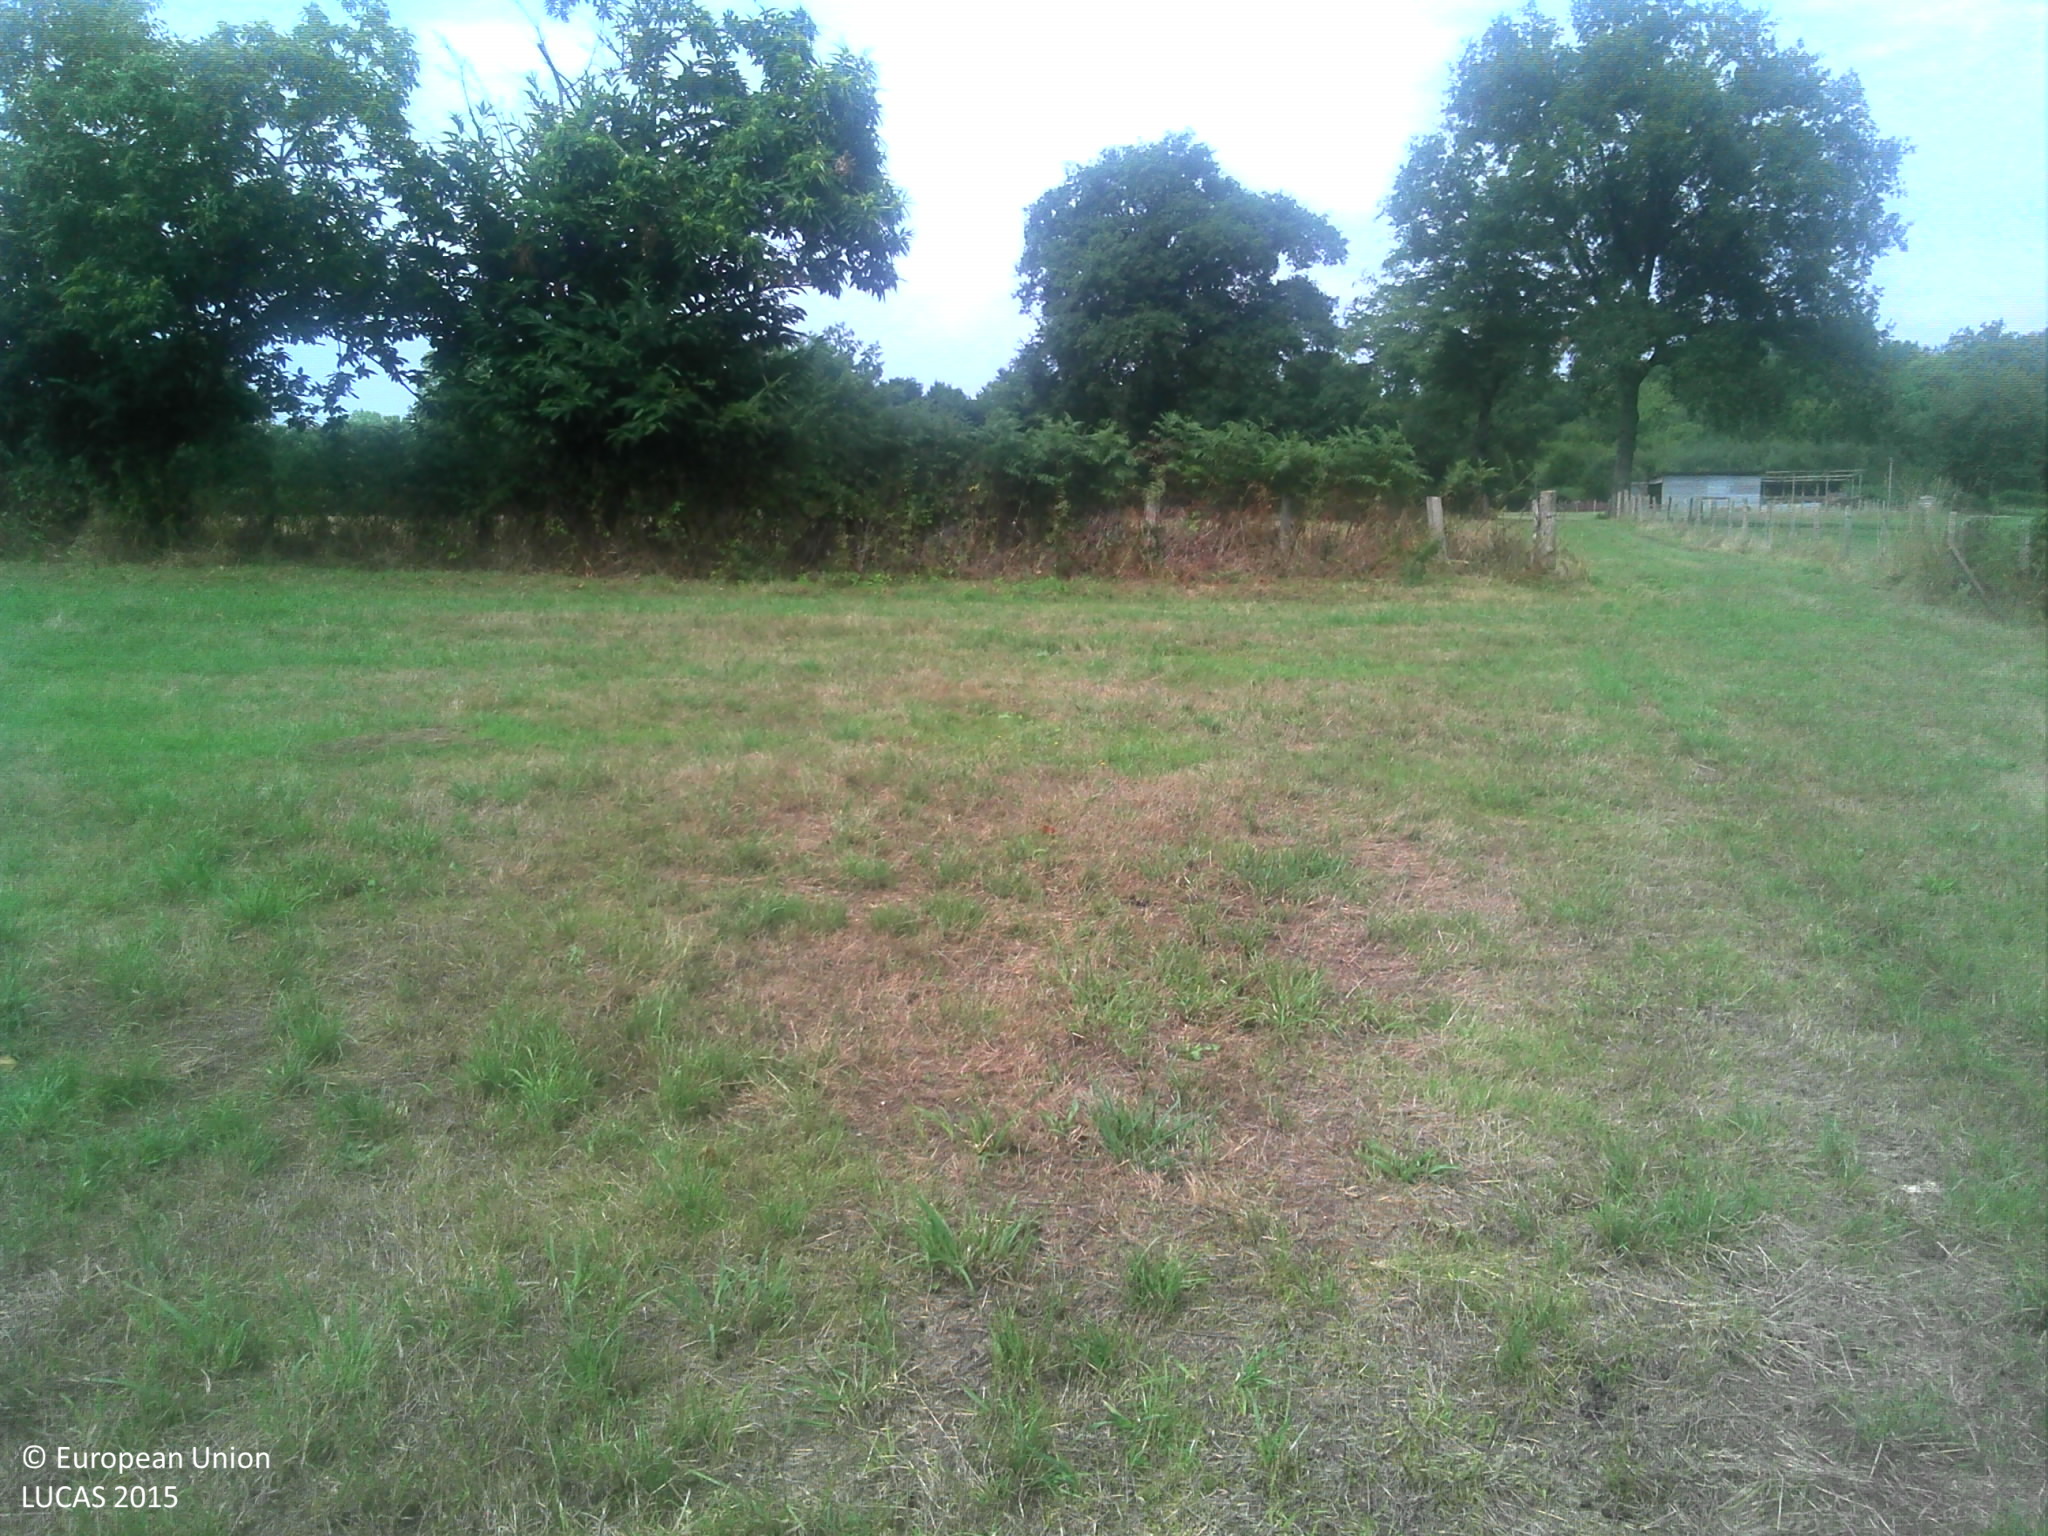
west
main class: Grassland
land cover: Grassland without tree/shrub cover
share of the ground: > 75 %
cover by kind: herbaceous plants 100 %
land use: Agriculture (excluding fallow land and kitchen gardens)
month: August
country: FR
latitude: 46.1270
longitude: 0.9149
